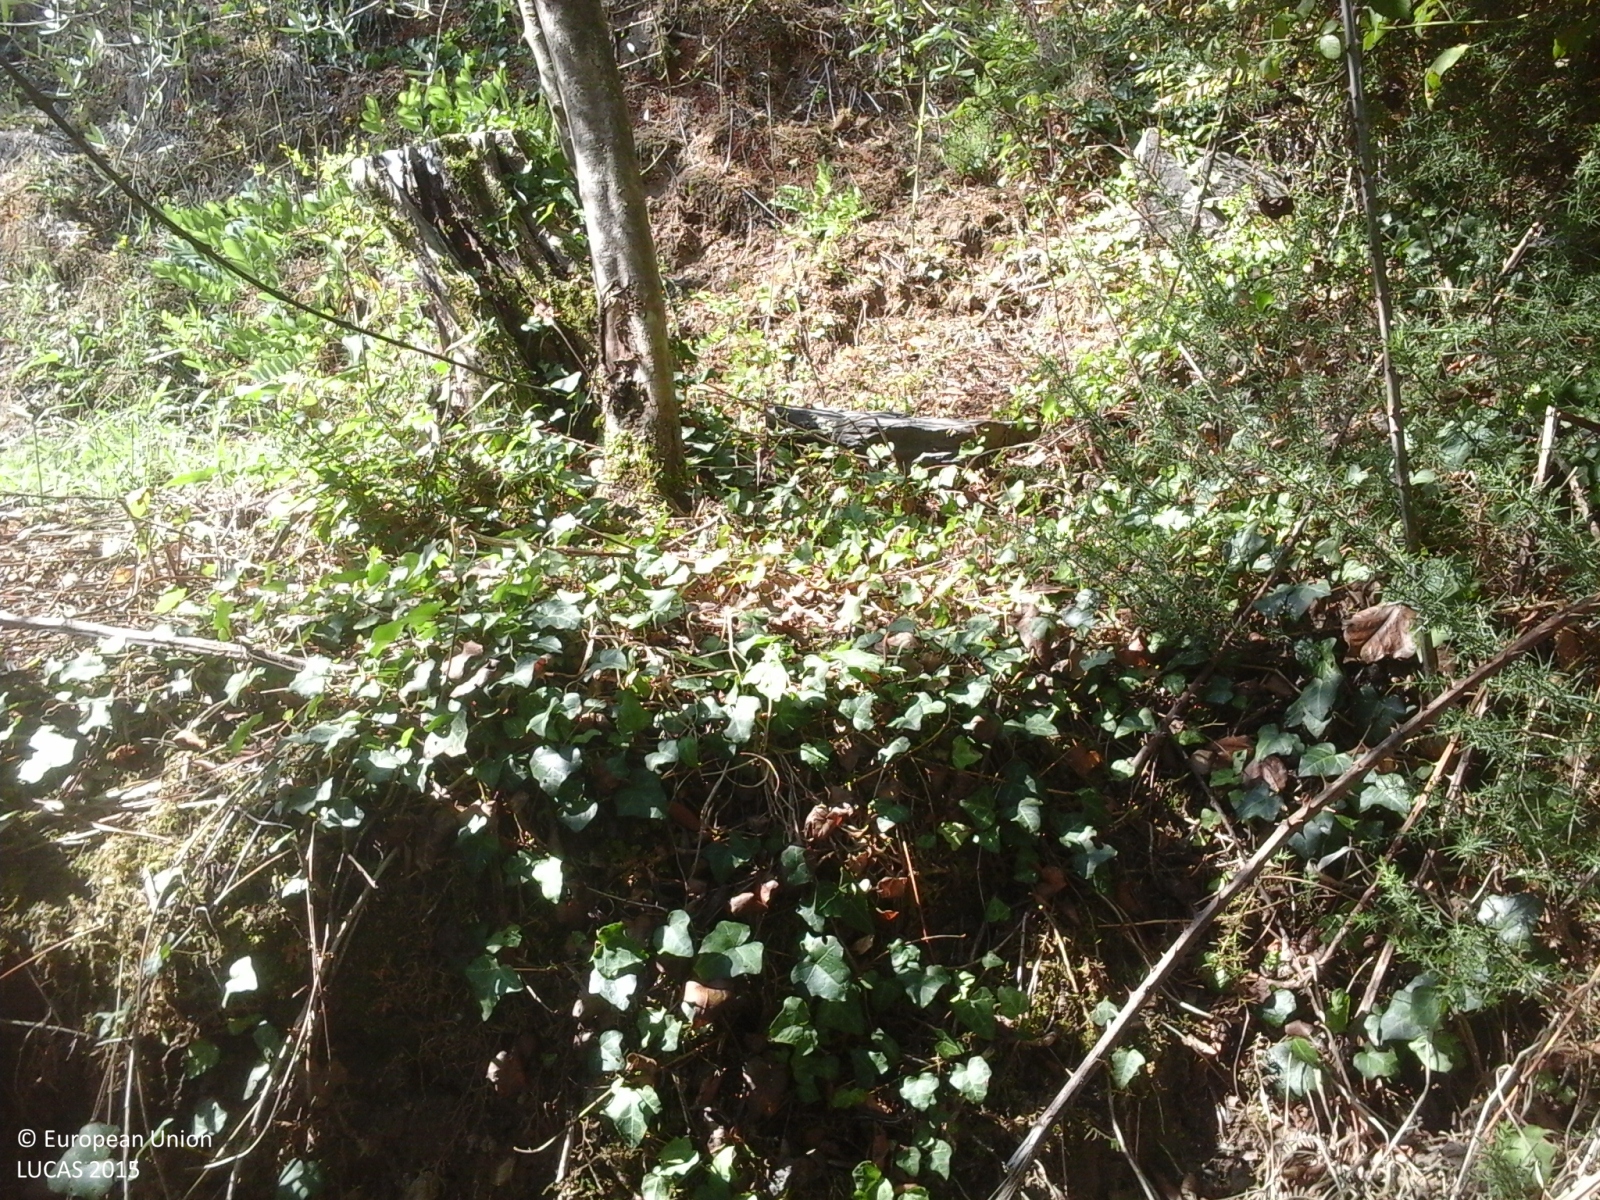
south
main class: Cropland
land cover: Olive groves
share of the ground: > 75 %
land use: Agriculture (excluding fallow land and kitchen gardens)
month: August
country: IT
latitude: 43.7354
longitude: 10.6067
